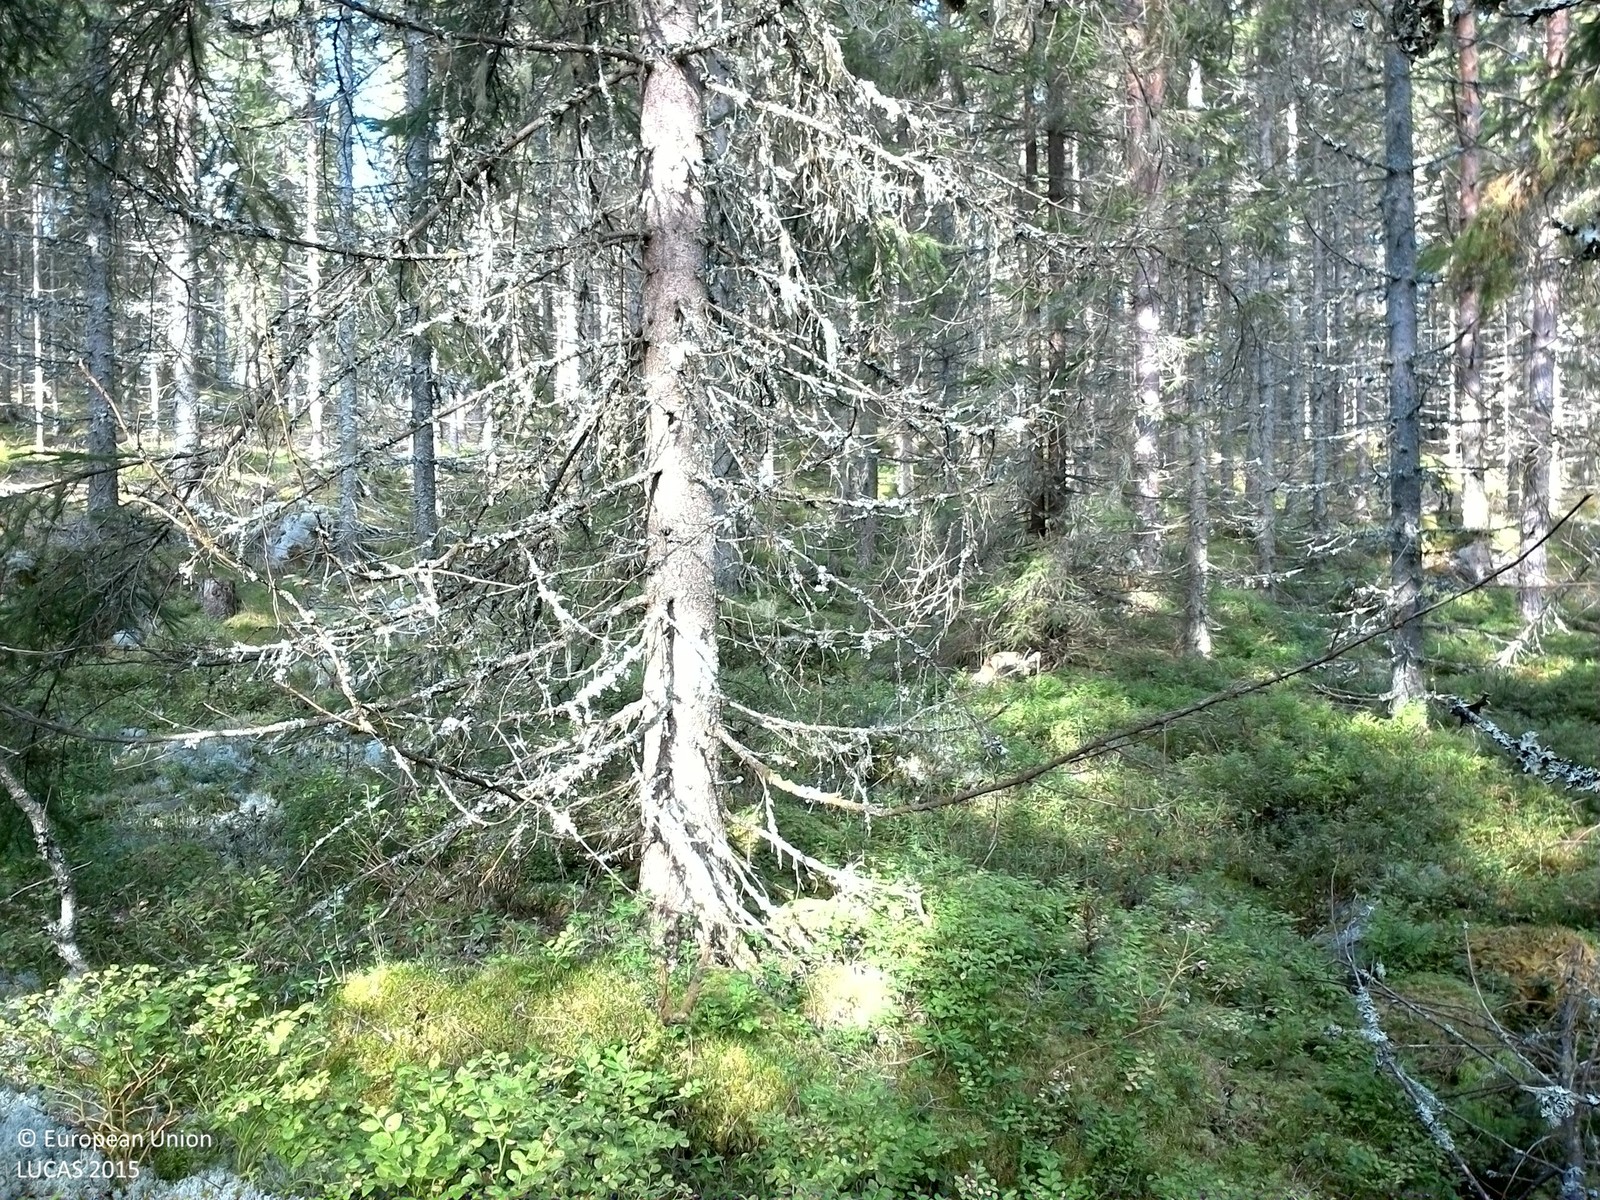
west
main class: Woodland
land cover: Spruce dominated coniferous woodland
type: boreal forest
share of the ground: 50 - 75 %
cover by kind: coniferous forest trees 70 %, shrubs 15 %, lichens and mosses 15 %
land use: Forestry
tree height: > 5 m
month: September
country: SE
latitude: 59.9395
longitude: 13.4810
